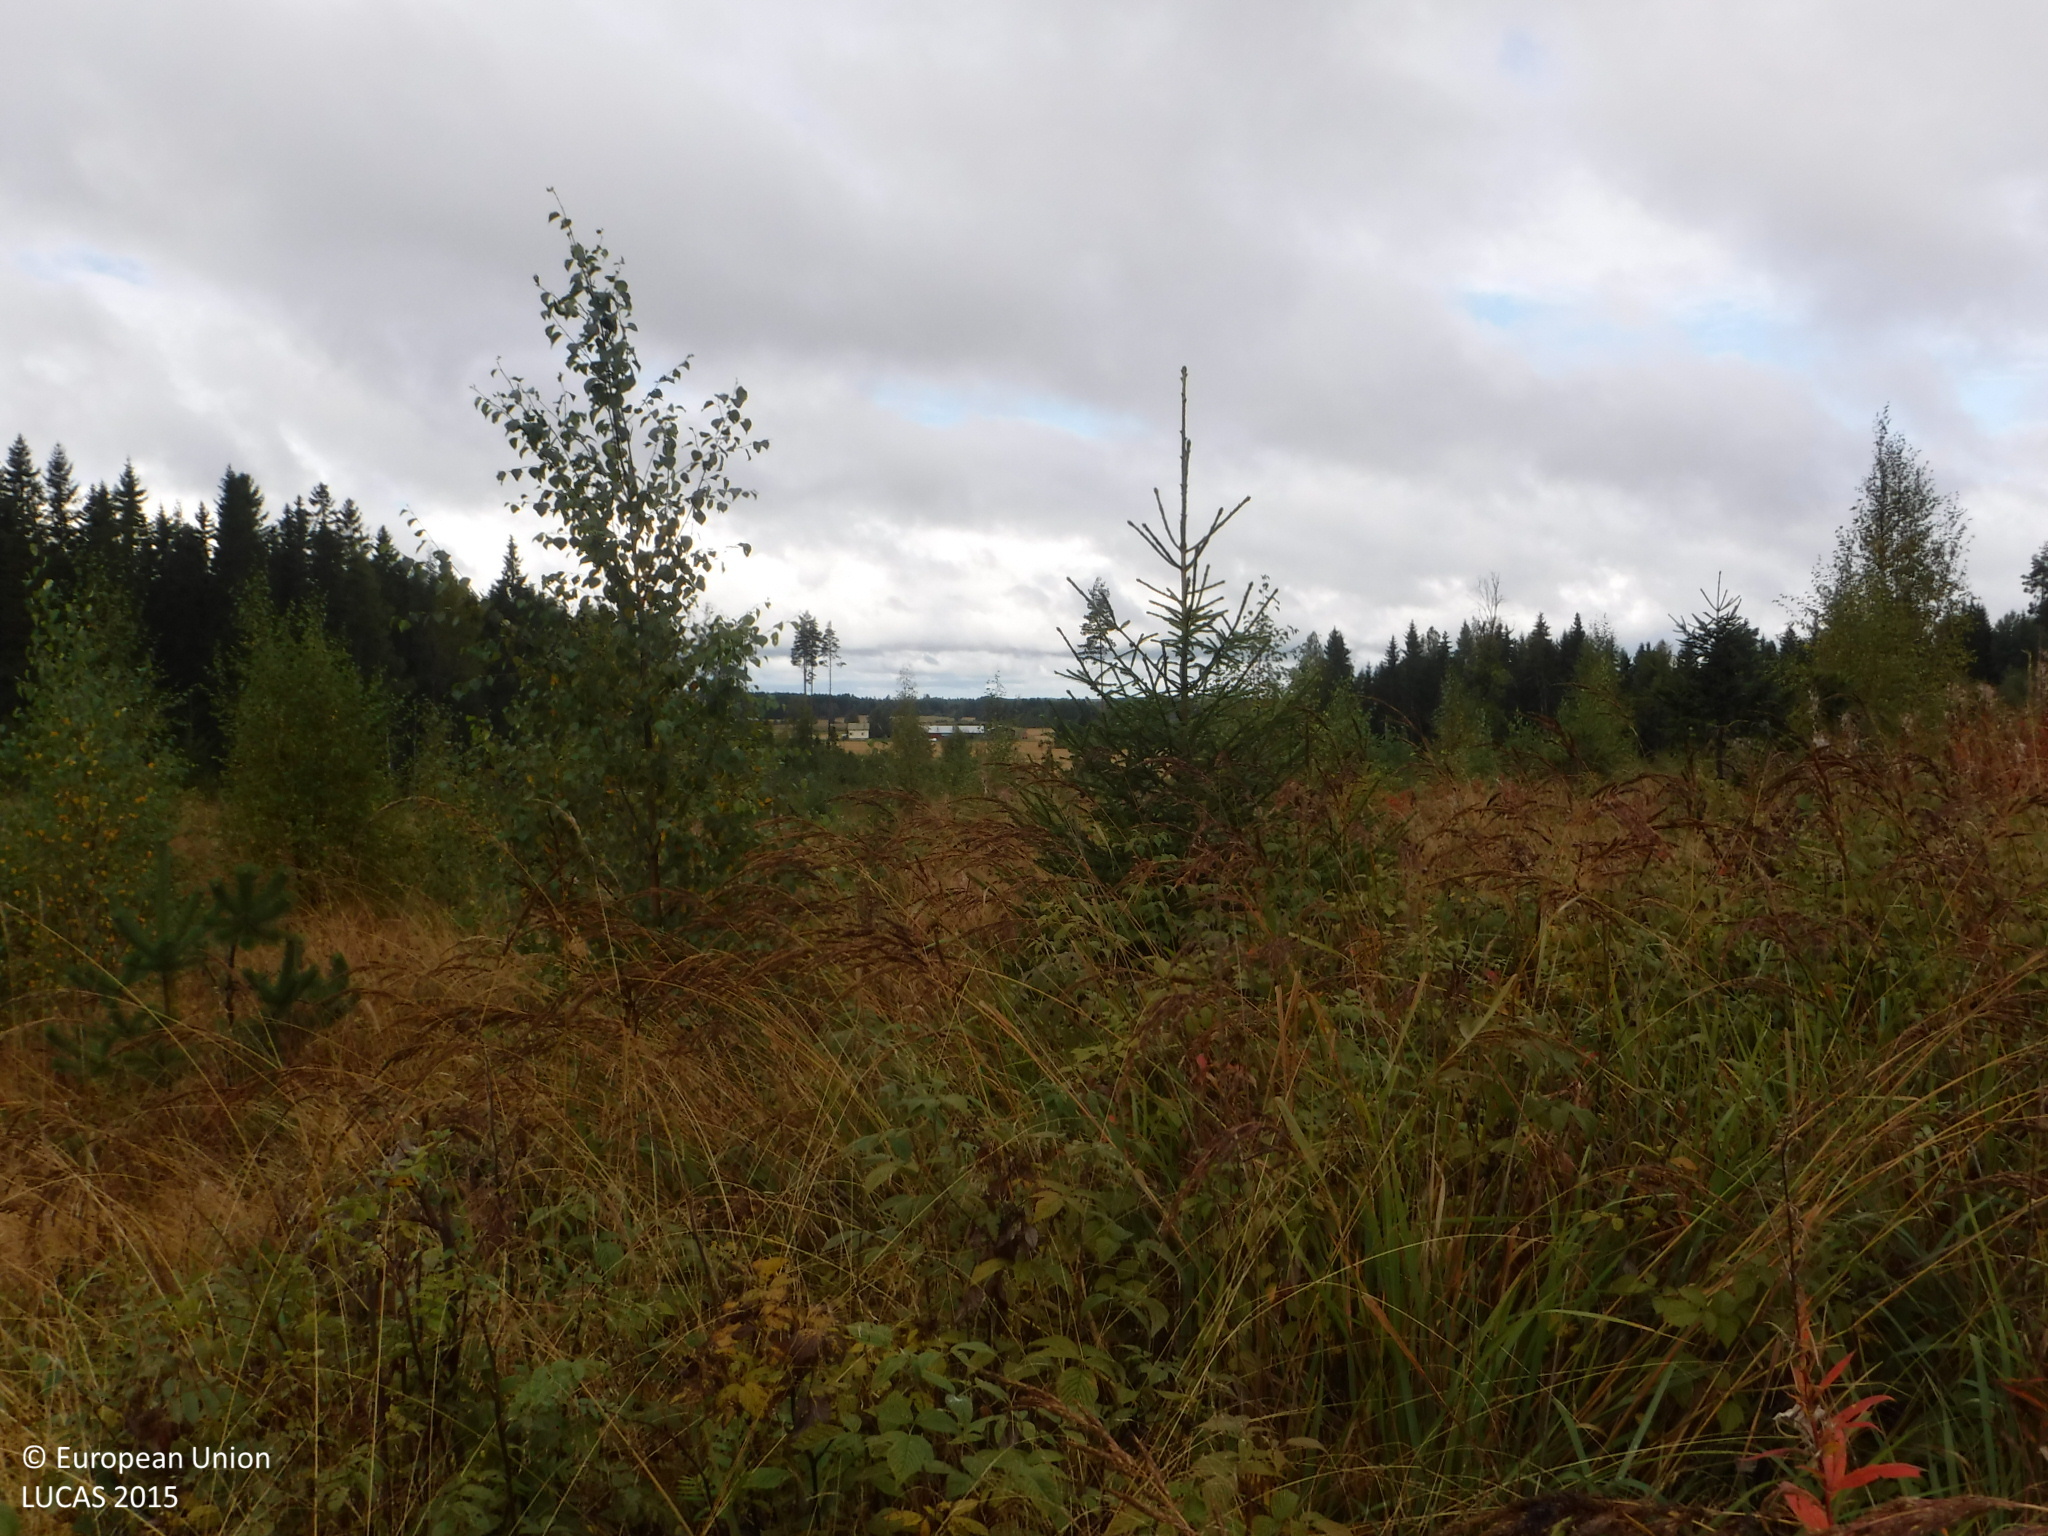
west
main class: Shrubland
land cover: Shrubland with sparse tree cover
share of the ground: 50 - 75 %
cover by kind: herbaceous plants 50 %, shrubs 45 %, broadleaved forest trees 5 %
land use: Forestry
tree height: < 5 m
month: September
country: FI
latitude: 61.3198
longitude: 23.1310
